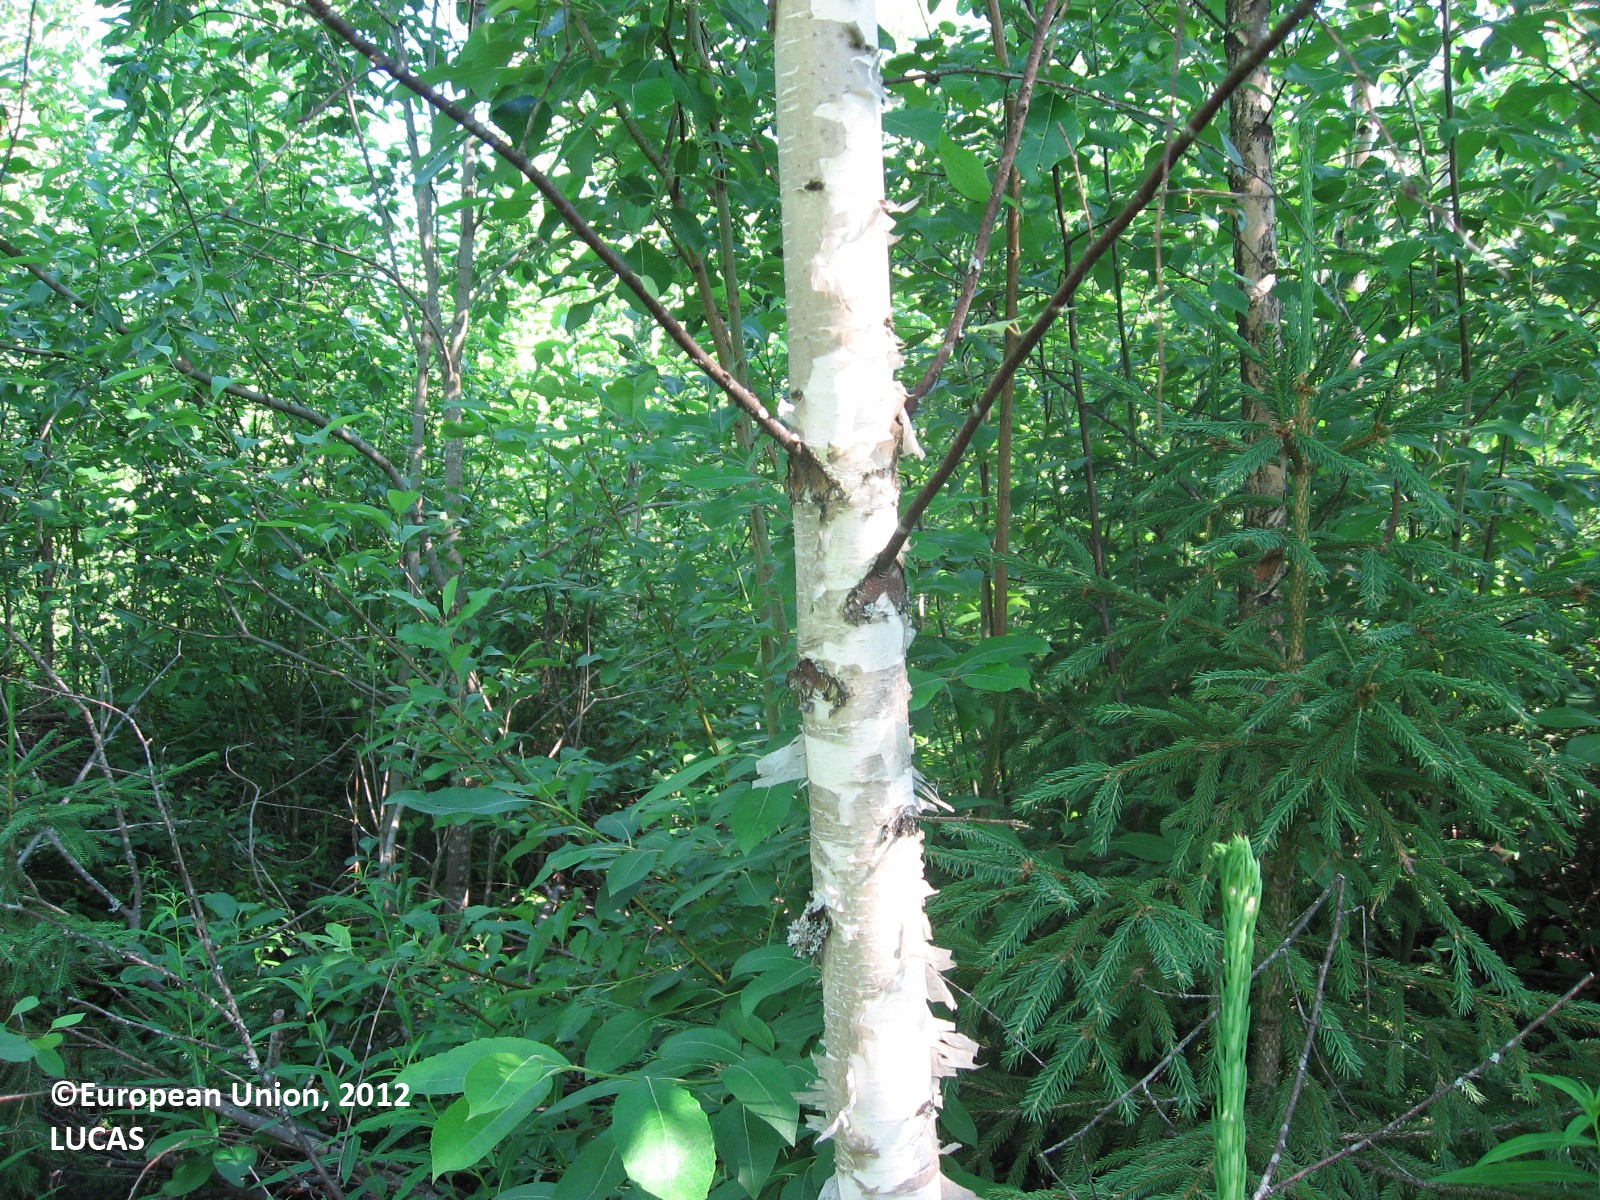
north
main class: Woodland
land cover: Spruce dominated mixed woodland
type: boreal forest
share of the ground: 50 - 75 %
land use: Forestry
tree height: > 5 m
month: July
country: FI
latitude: 60.9533
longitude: 26.4925
